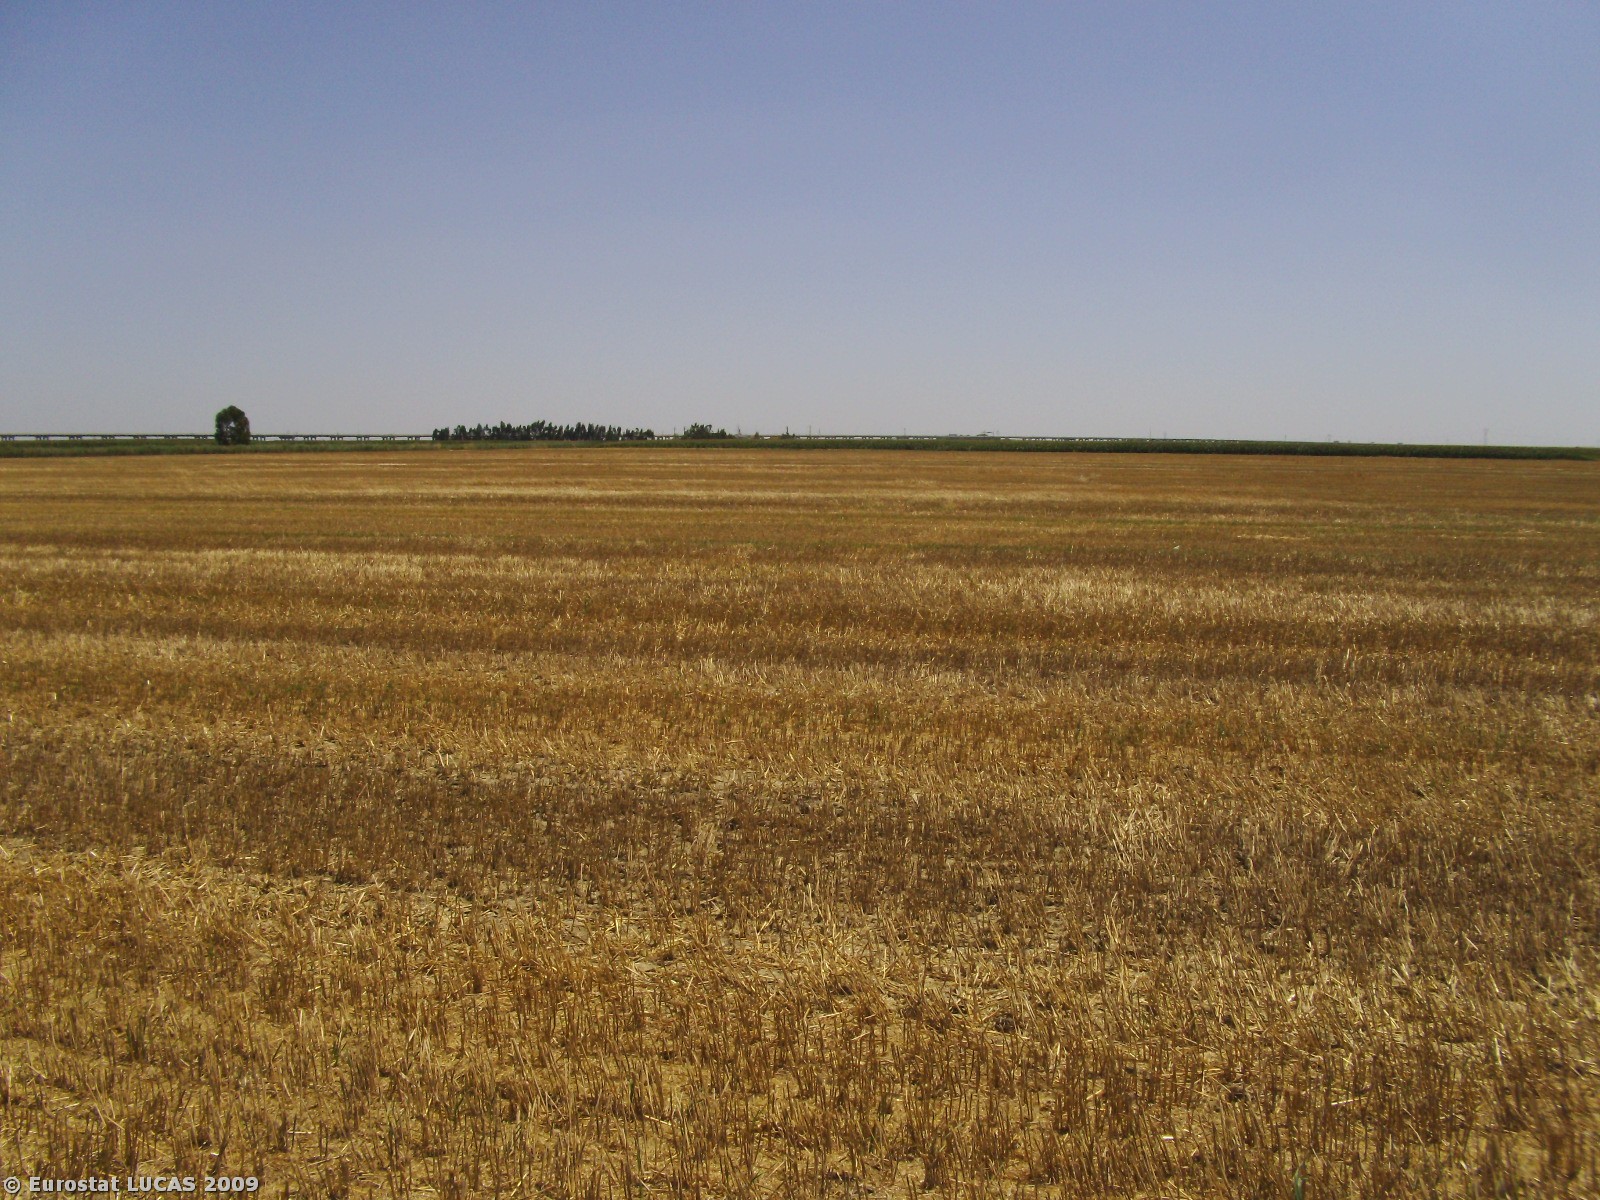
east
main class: Cropland
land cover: Common wheat
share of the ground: > 75 %
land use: Agriculture (excluding fallow land and kitchen gardens)
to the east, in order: Common wheat
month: July
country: PT
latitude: 38.9981
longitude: -8.9300
